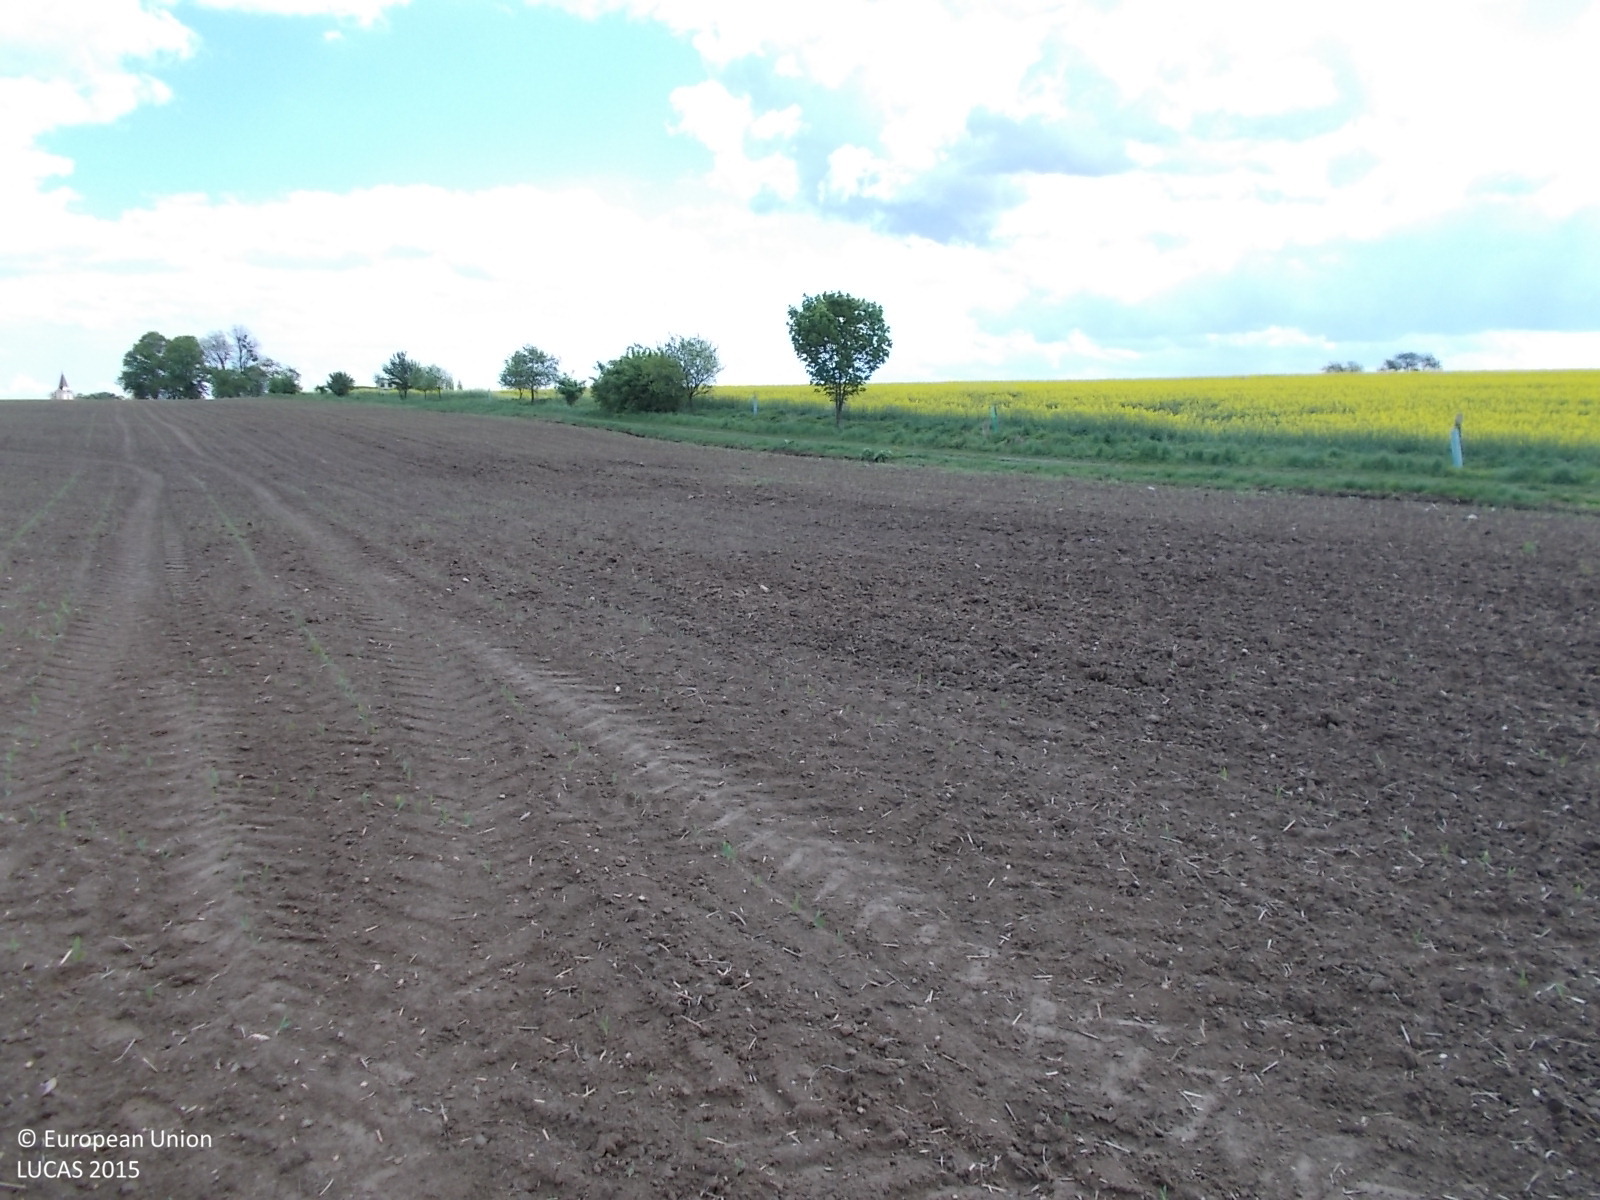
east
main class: Cropland
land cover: Maize
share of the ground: < 10 %
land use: Agriculture (excluding fallow land and kitchen gardens)
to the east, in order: Maize; Grass margins; Tracks; Grass margins; Lines of trees; Grass margins; Rape and turnip rape
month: May
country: CZ
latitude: 49.9225
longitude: 17.7162
